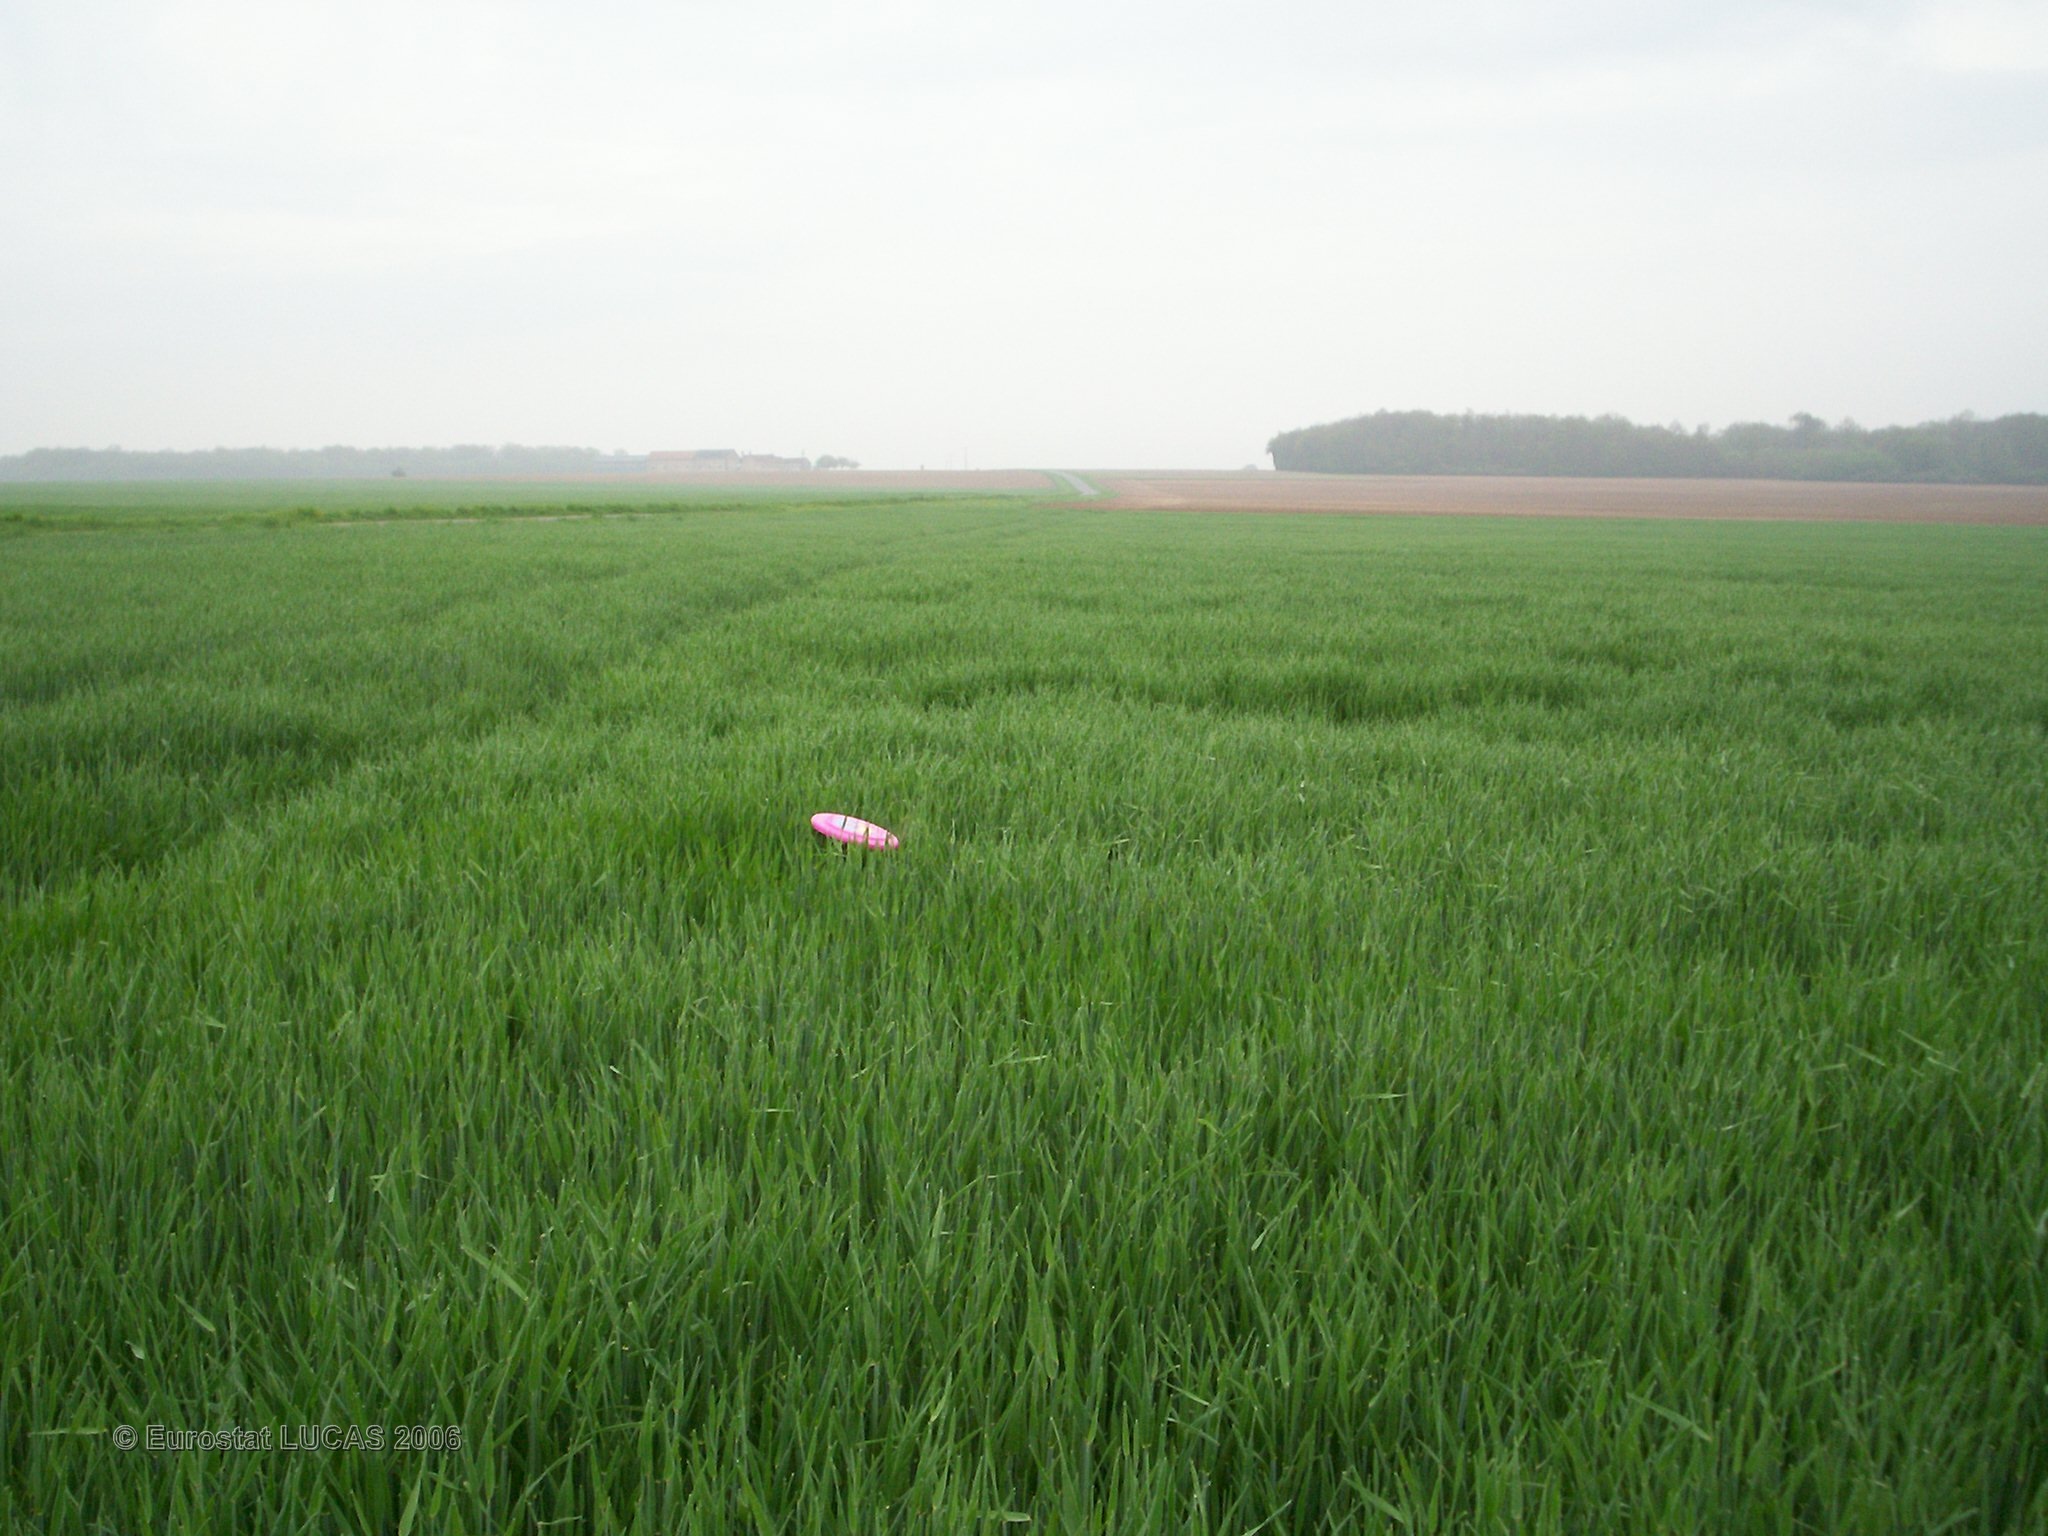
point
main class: Cropland
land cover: Barley
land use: Agriculture (excluding fallow land and kitchen gardens)
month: April
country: FR
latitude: 47.8856
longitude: 2.8916
